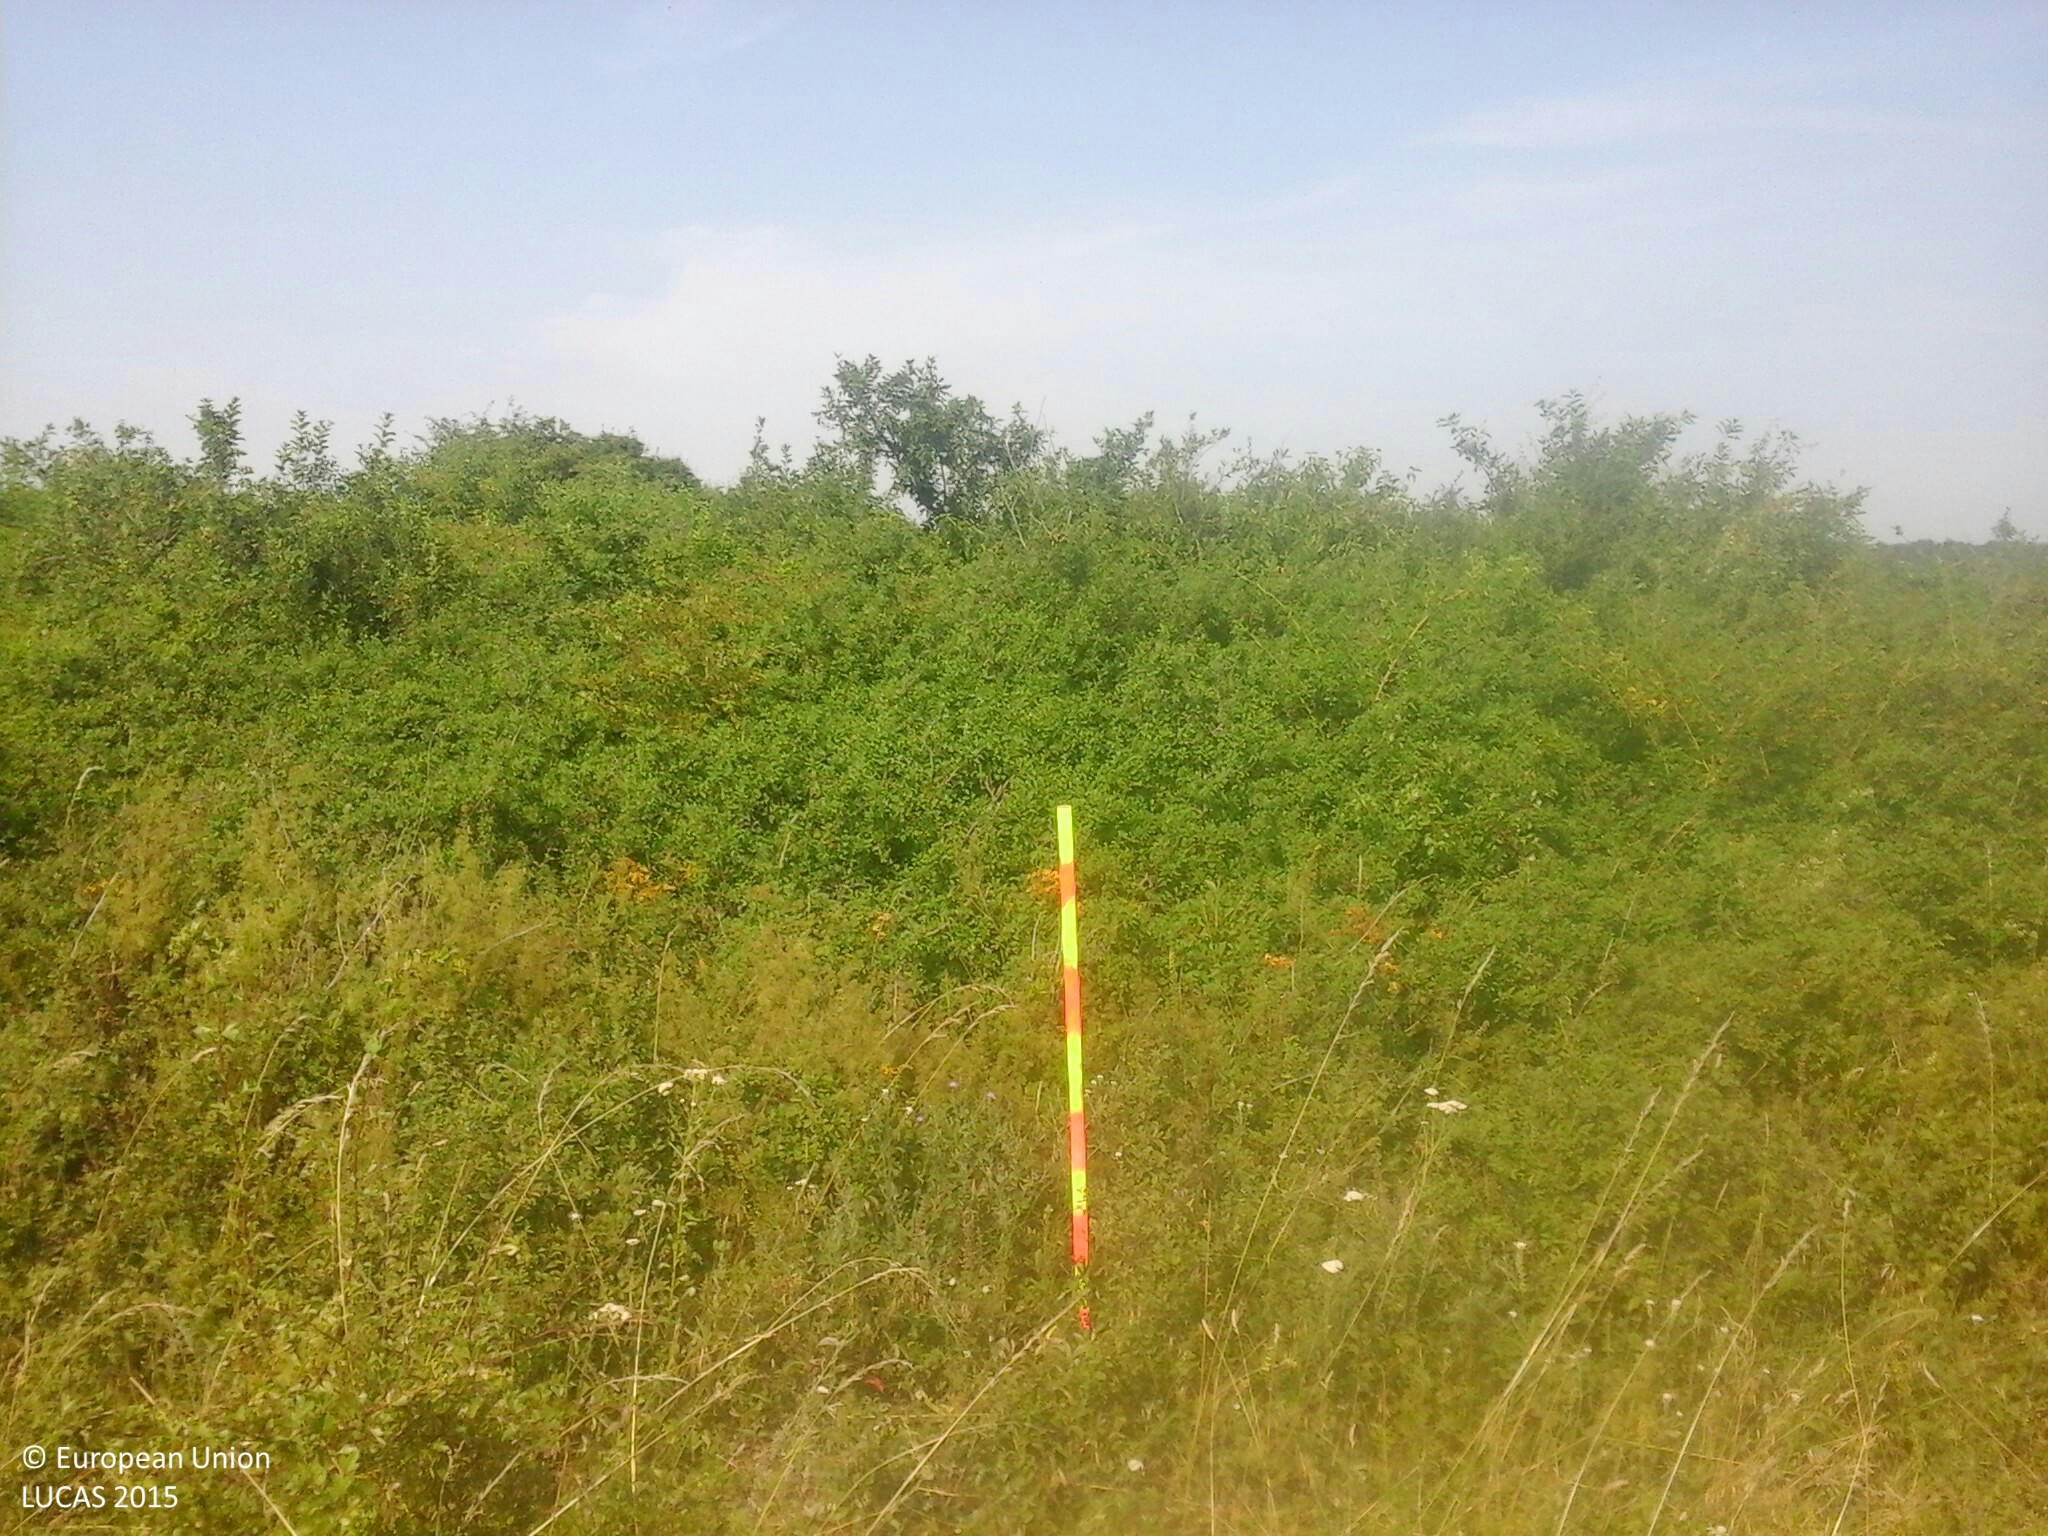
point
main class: Shrubland
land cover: Shrubland without tree cover
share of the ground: > 75 %
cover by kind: shrubs 95 %, herbaceous plants 5 %
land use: Semi-natural and natural areas not in use
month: July
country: HU
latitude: 46.9920
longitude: 17.7526
